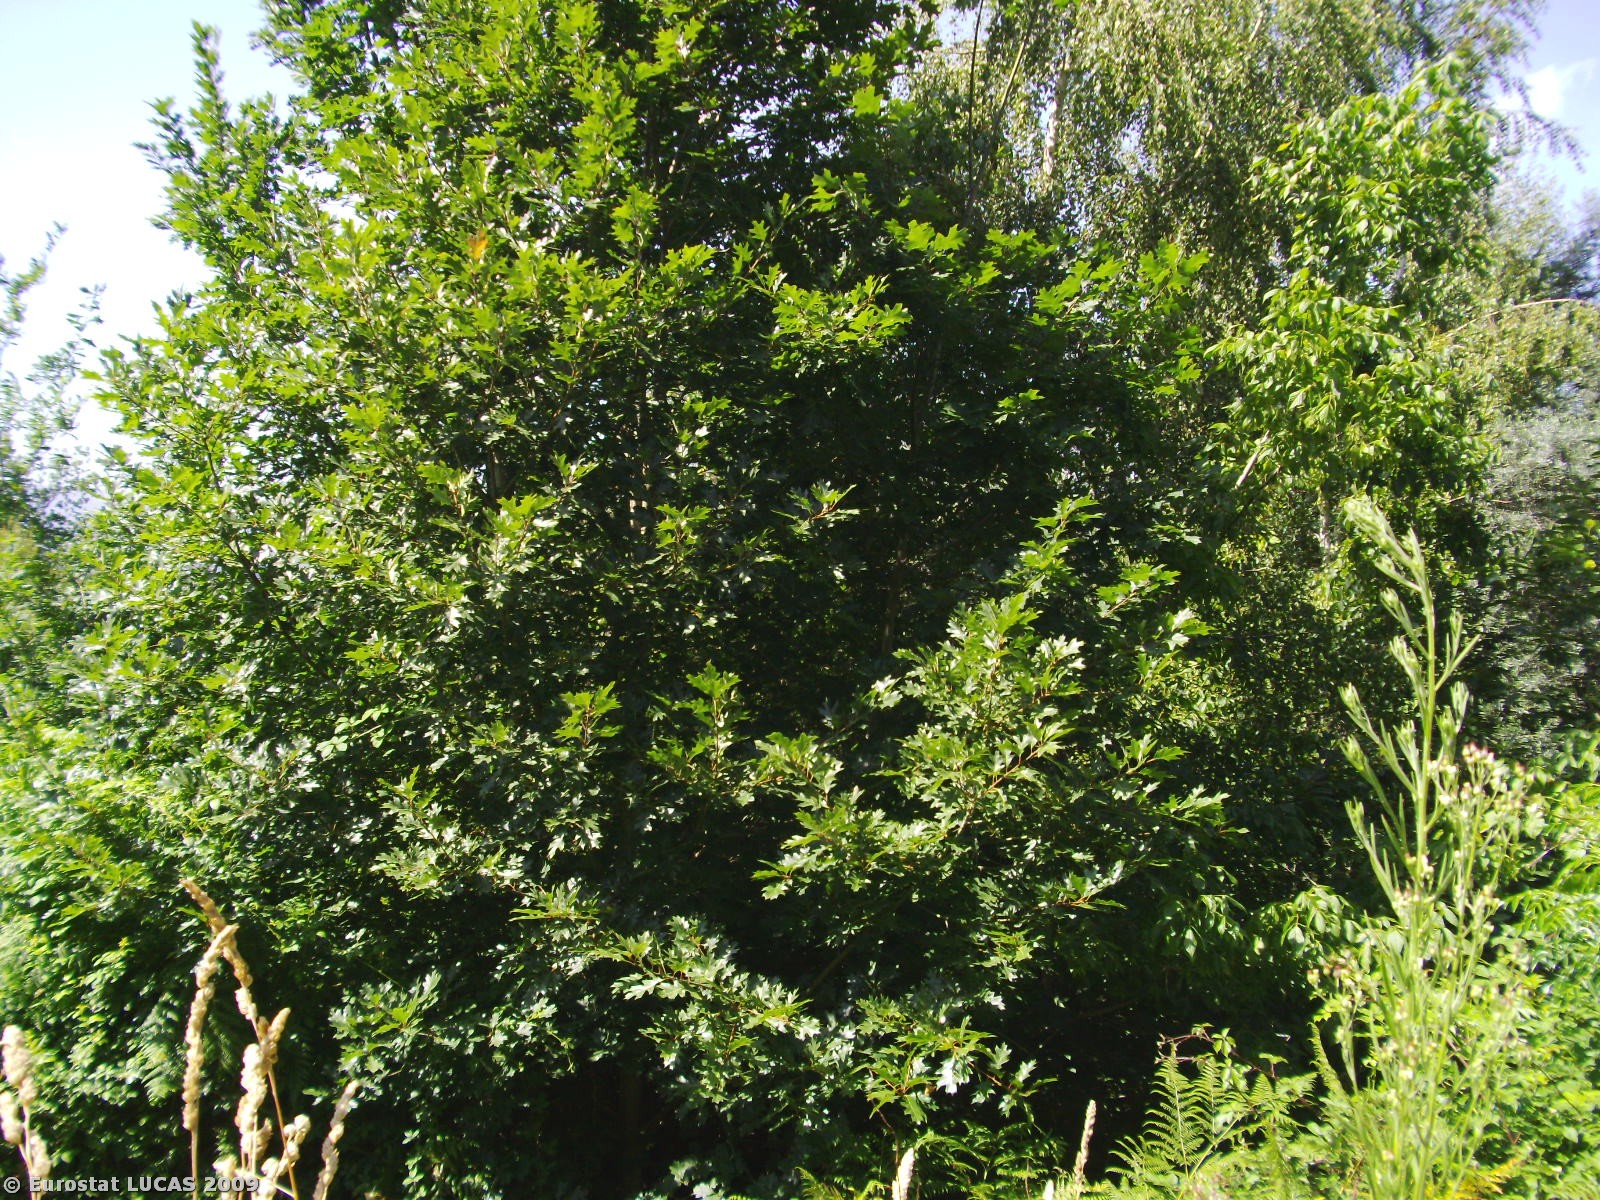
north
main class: Grassland
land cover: Spontaneously vegetated surfaces
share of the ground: > 75 %
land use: Fallow land
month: July
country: PT
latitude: 41.7151
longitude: -8.5622
